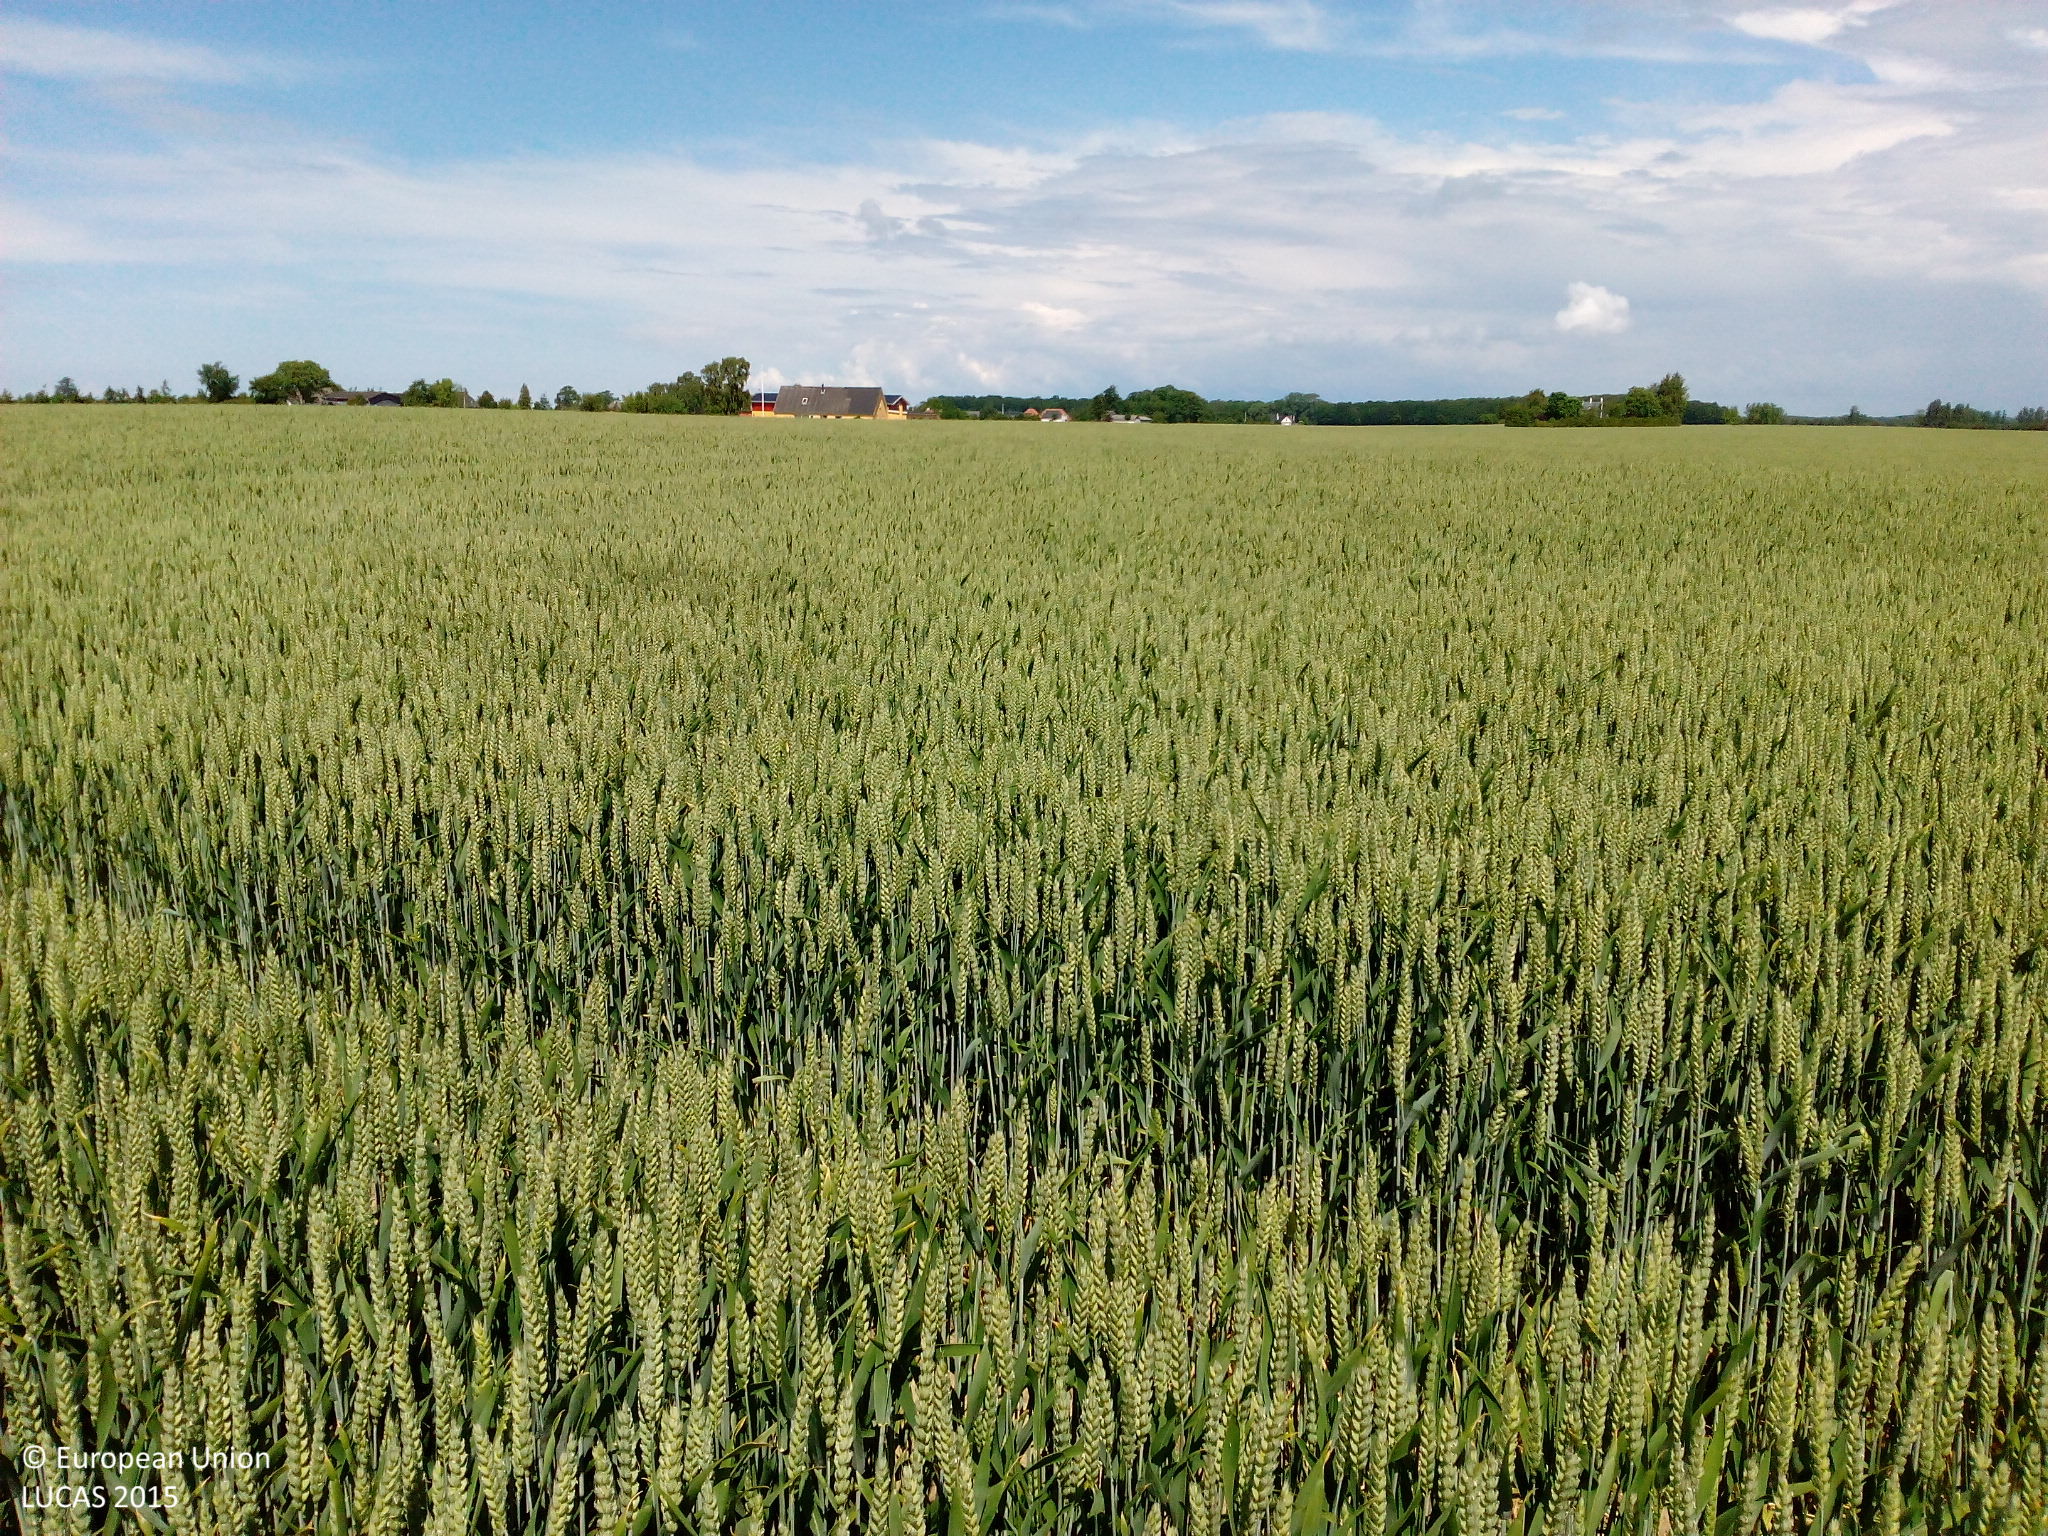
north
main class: Cropland
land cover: Common wheat
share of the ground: > 75 %
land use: Agriculture (excluding fallow land and kitchen gardens)
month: June
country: DK
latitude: 54.8122
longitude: 11.5394
